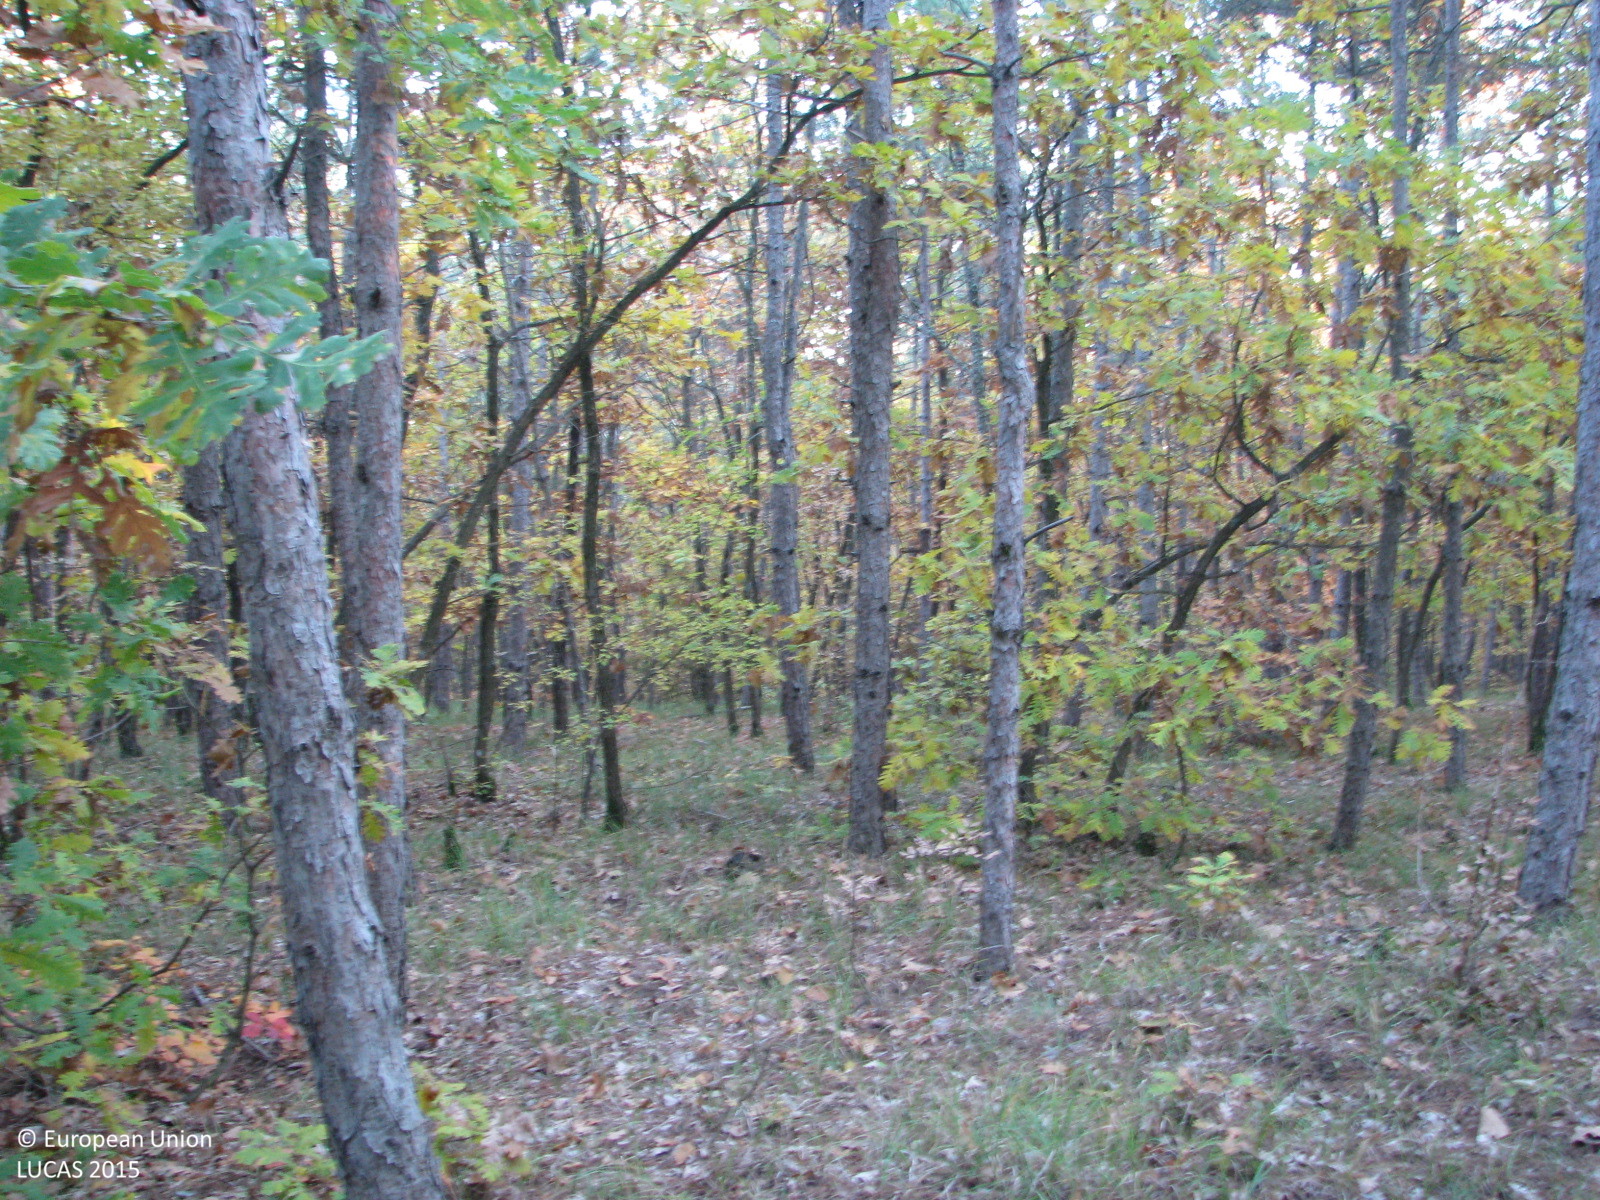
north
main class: Woodland
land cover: Pine dominated mixed woodland
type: hemiboreal forest and nemoral coniferous forest and mixed broadleaved-coniferous forest
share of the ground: 50 - 75 %
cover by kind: coniferous forest trees 40 %, herbaceous plants 30 %, broadleaved forest trees 20 %, shrubs 10 %
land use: Forestry
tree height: > 5 m
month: November
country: BG
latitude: 41.9730
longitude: 26.4850
